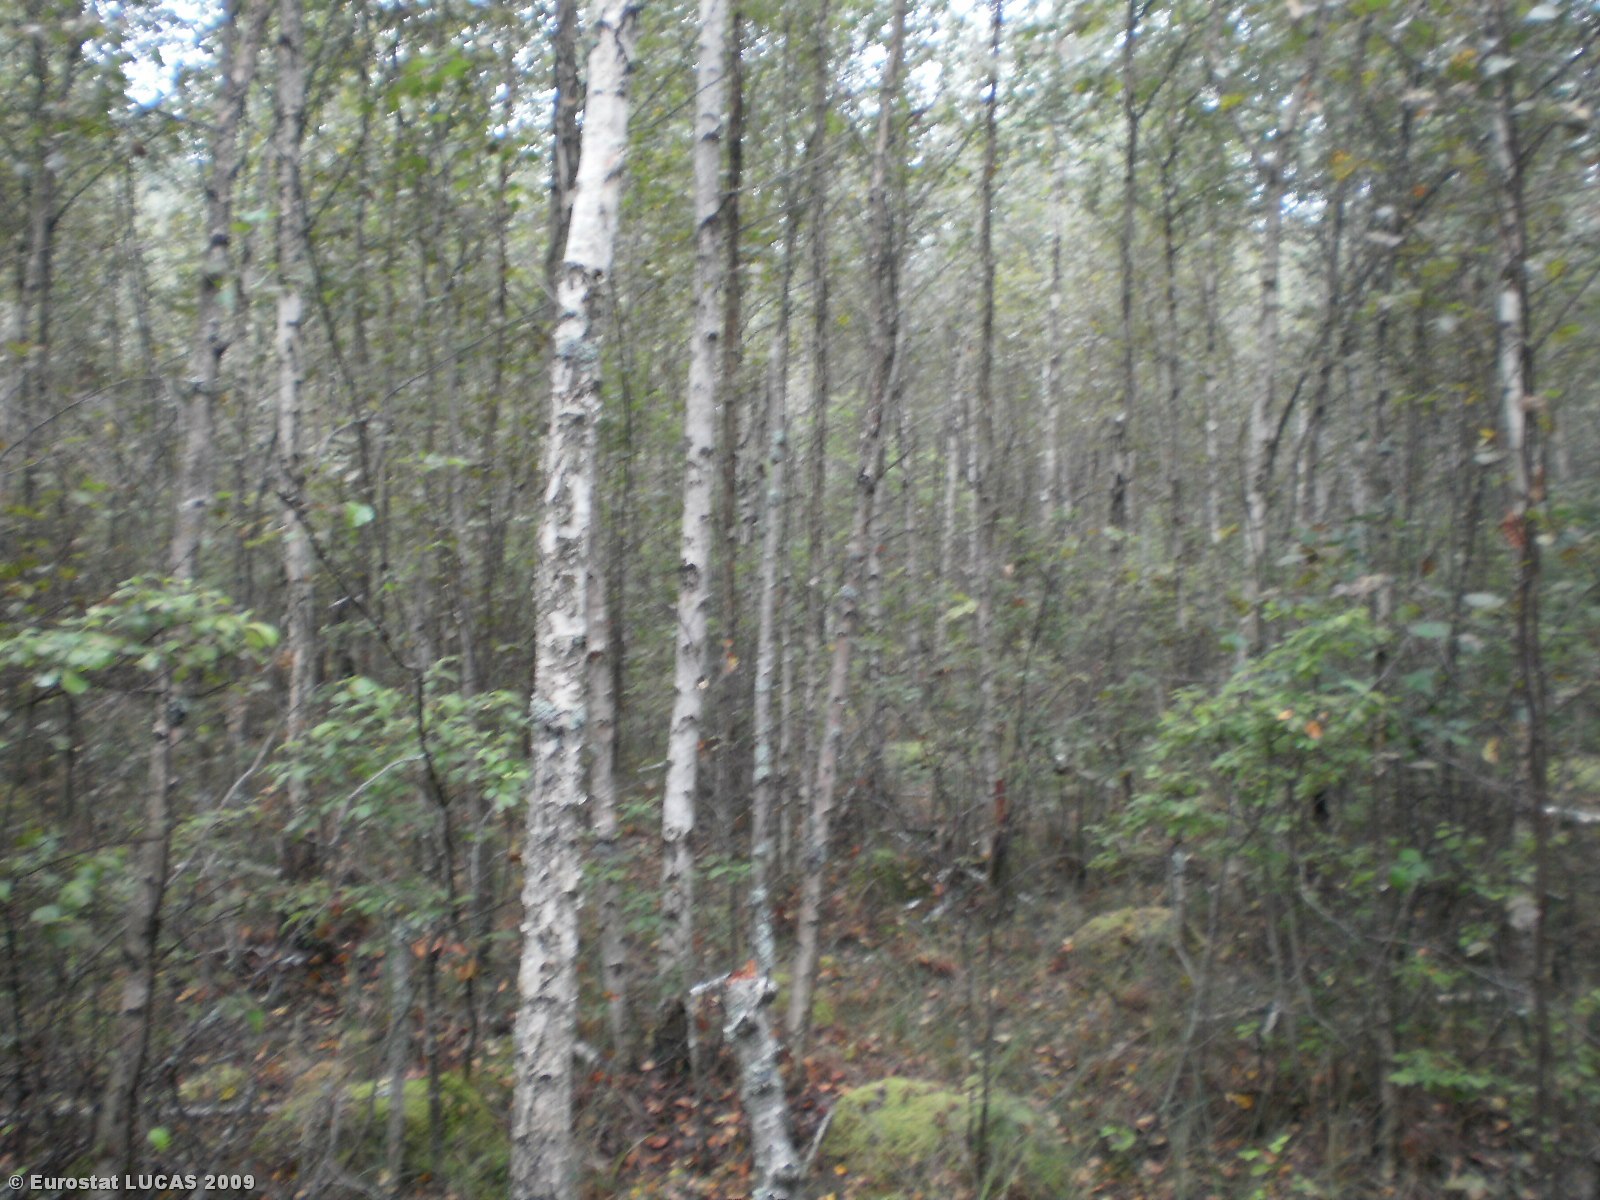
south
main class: Woodland
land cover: Broadleaved woodland
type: mire and swamp forests
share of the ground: > 75 %
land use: Forestry
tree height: > 5 m
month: August
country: LT
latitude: 55.3670
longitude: 25.6378
